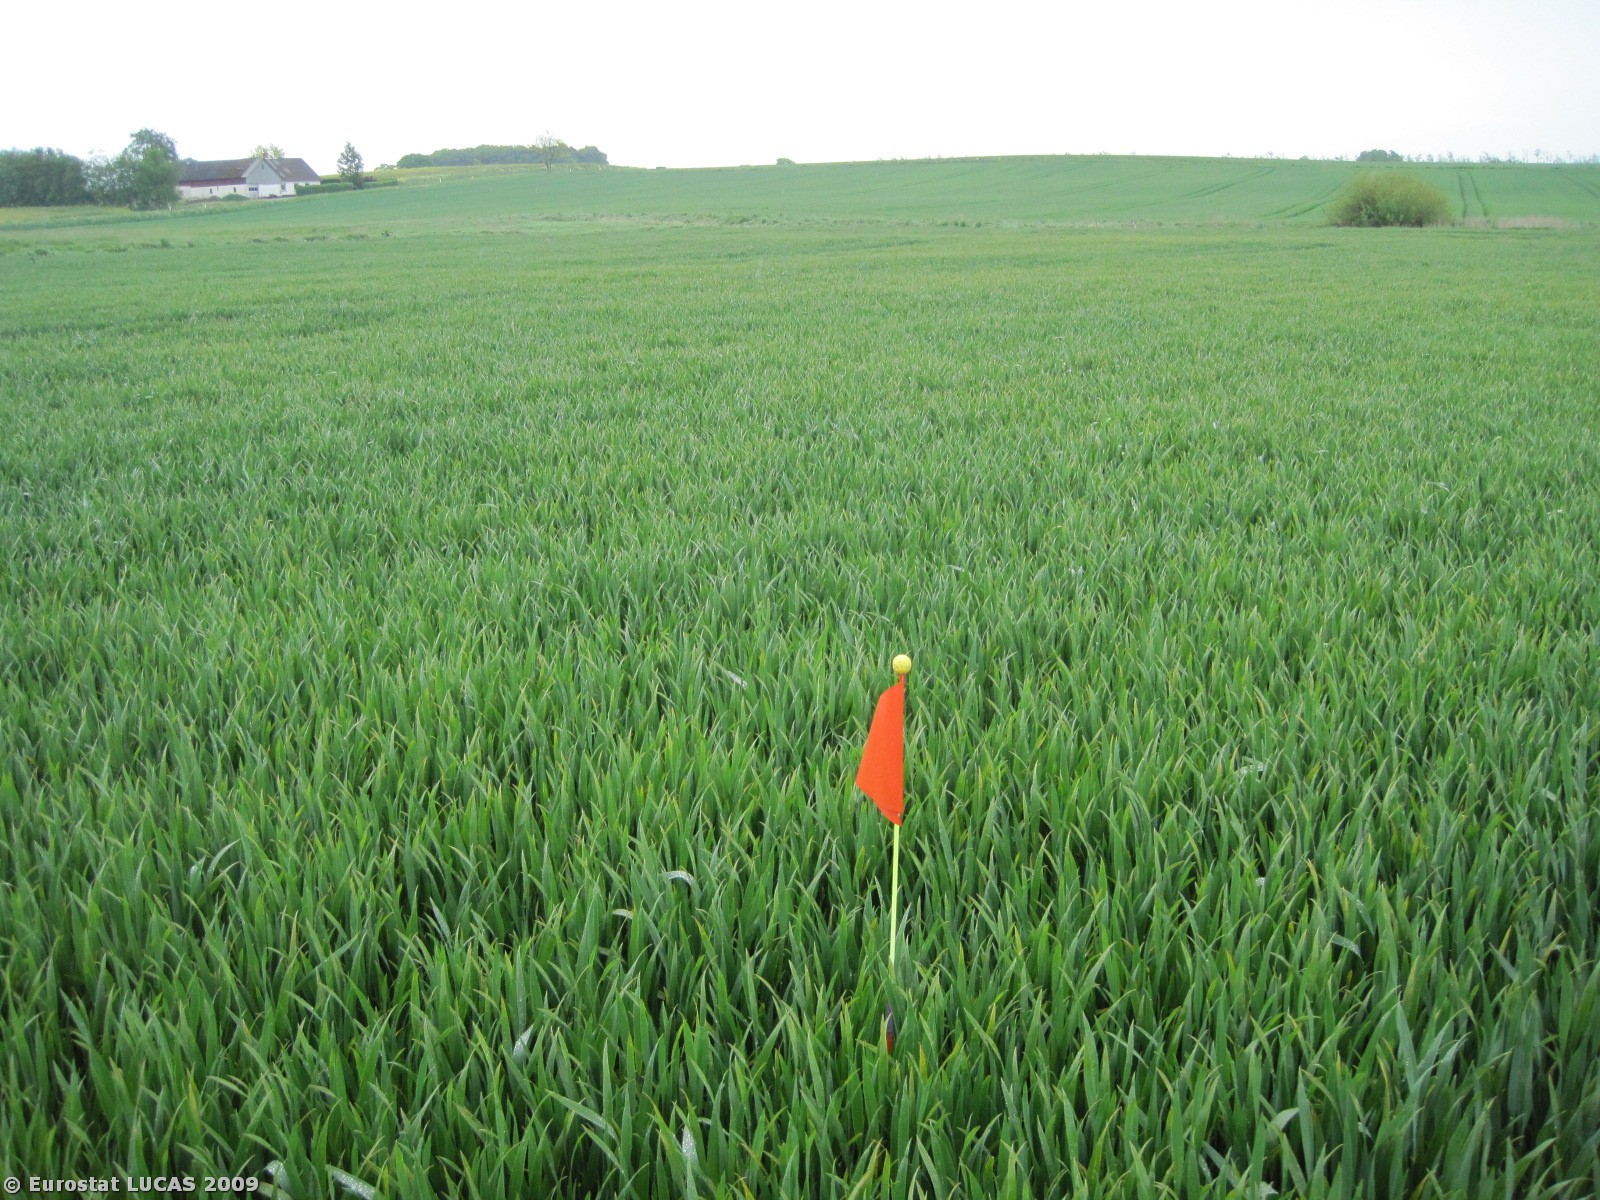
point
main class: Cropland
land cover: Common wheat
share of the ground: > 75 %
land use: Agriculture (excluding fallow land and kitchen gardens)
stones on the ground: < 10 %
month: May
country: DK
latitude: 56.7629
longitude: 10.1470
